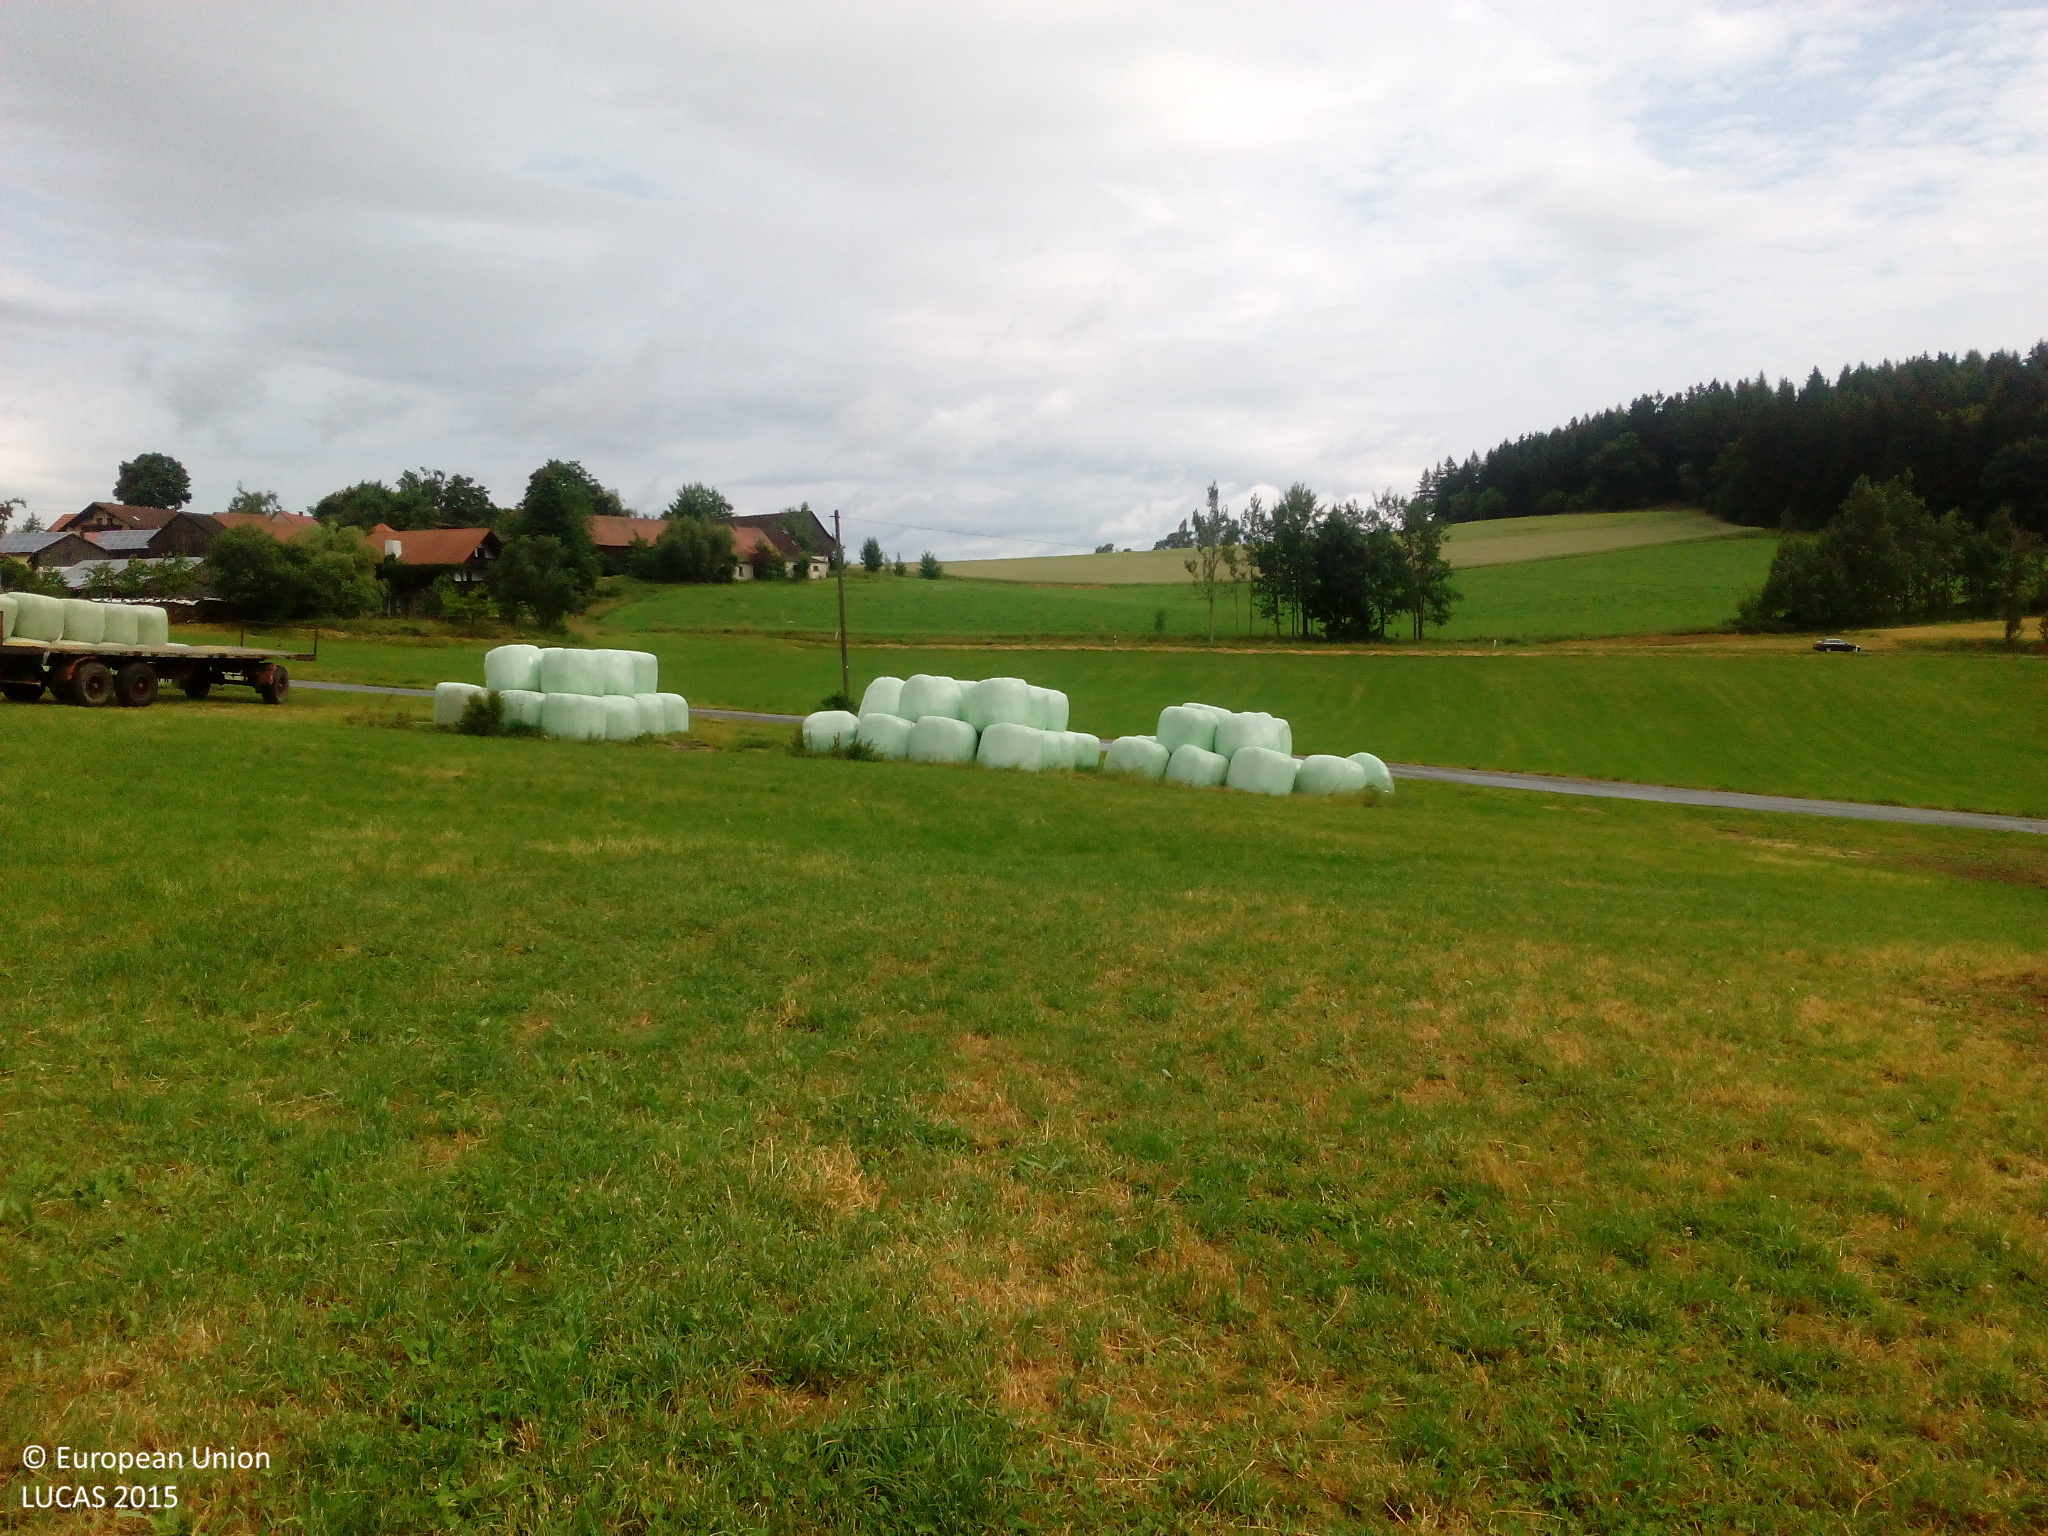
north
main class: Grassland
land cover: Grassland without tree/shrub cover
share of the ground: > 75 %
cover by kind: herbaceous plants 95 %, unconsolidated bare surface 5 %
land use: Agriculture (excluding fallow land and kitchen gardens)
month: July
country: DE
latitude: 49.6739
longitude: 12.3692
